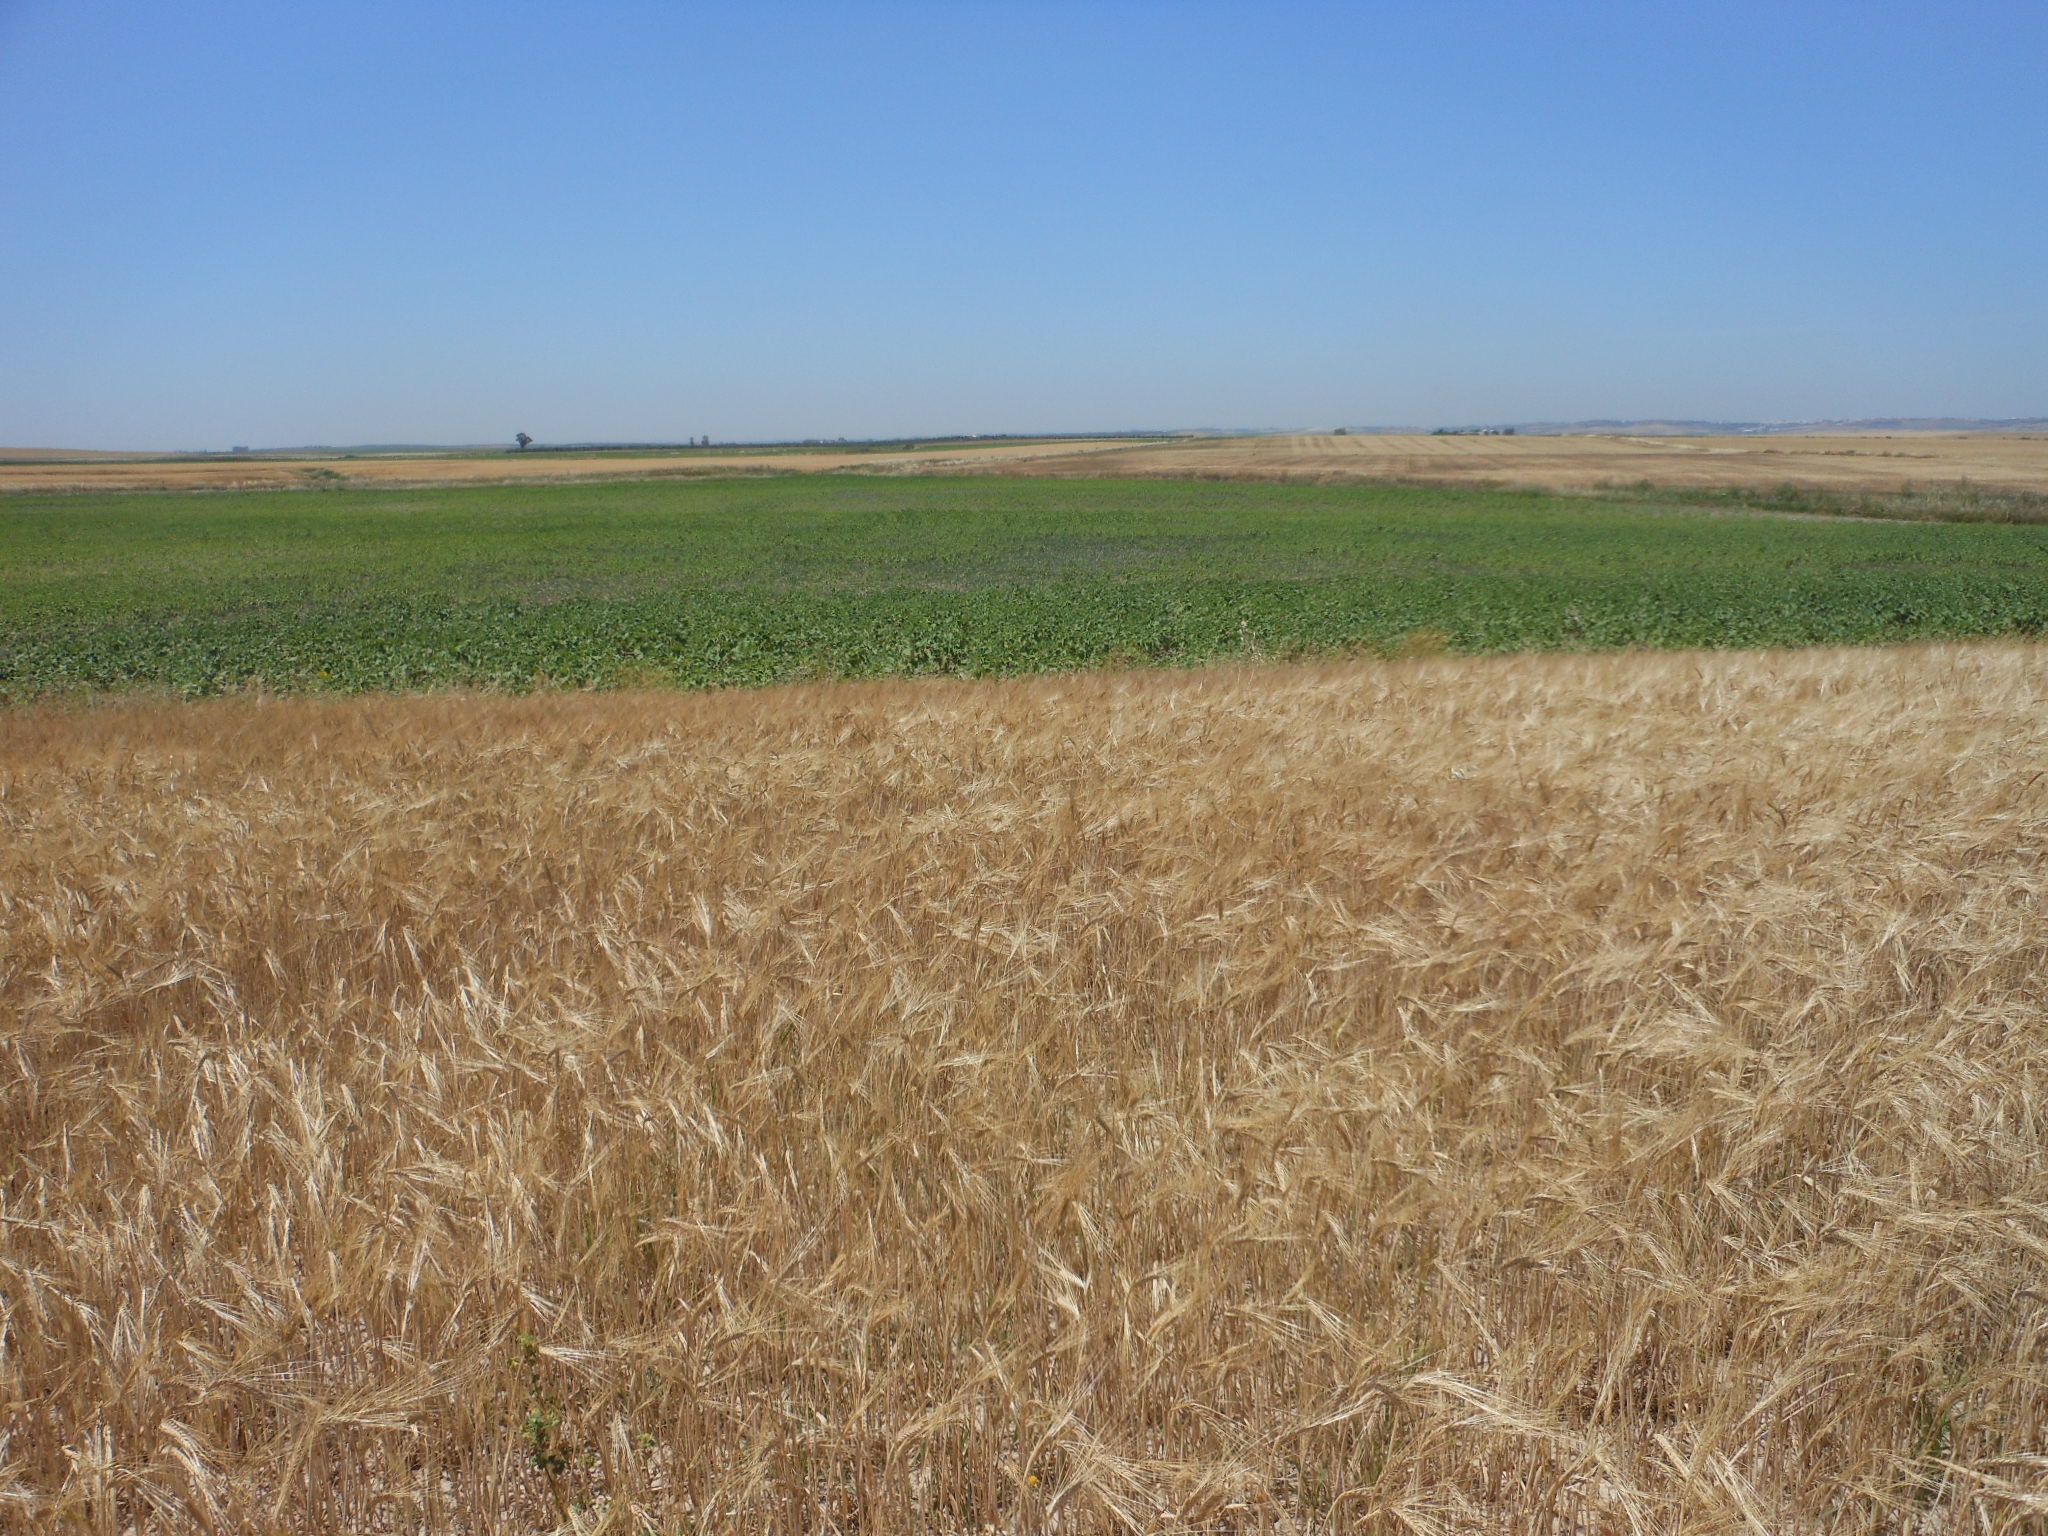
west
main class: Cropland
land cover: Barley
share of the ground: > 75 %
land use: Agriculture (excluding fallow land and kitchen gardens)
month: May
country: ES
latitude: 37.3390
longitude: -5.5815
